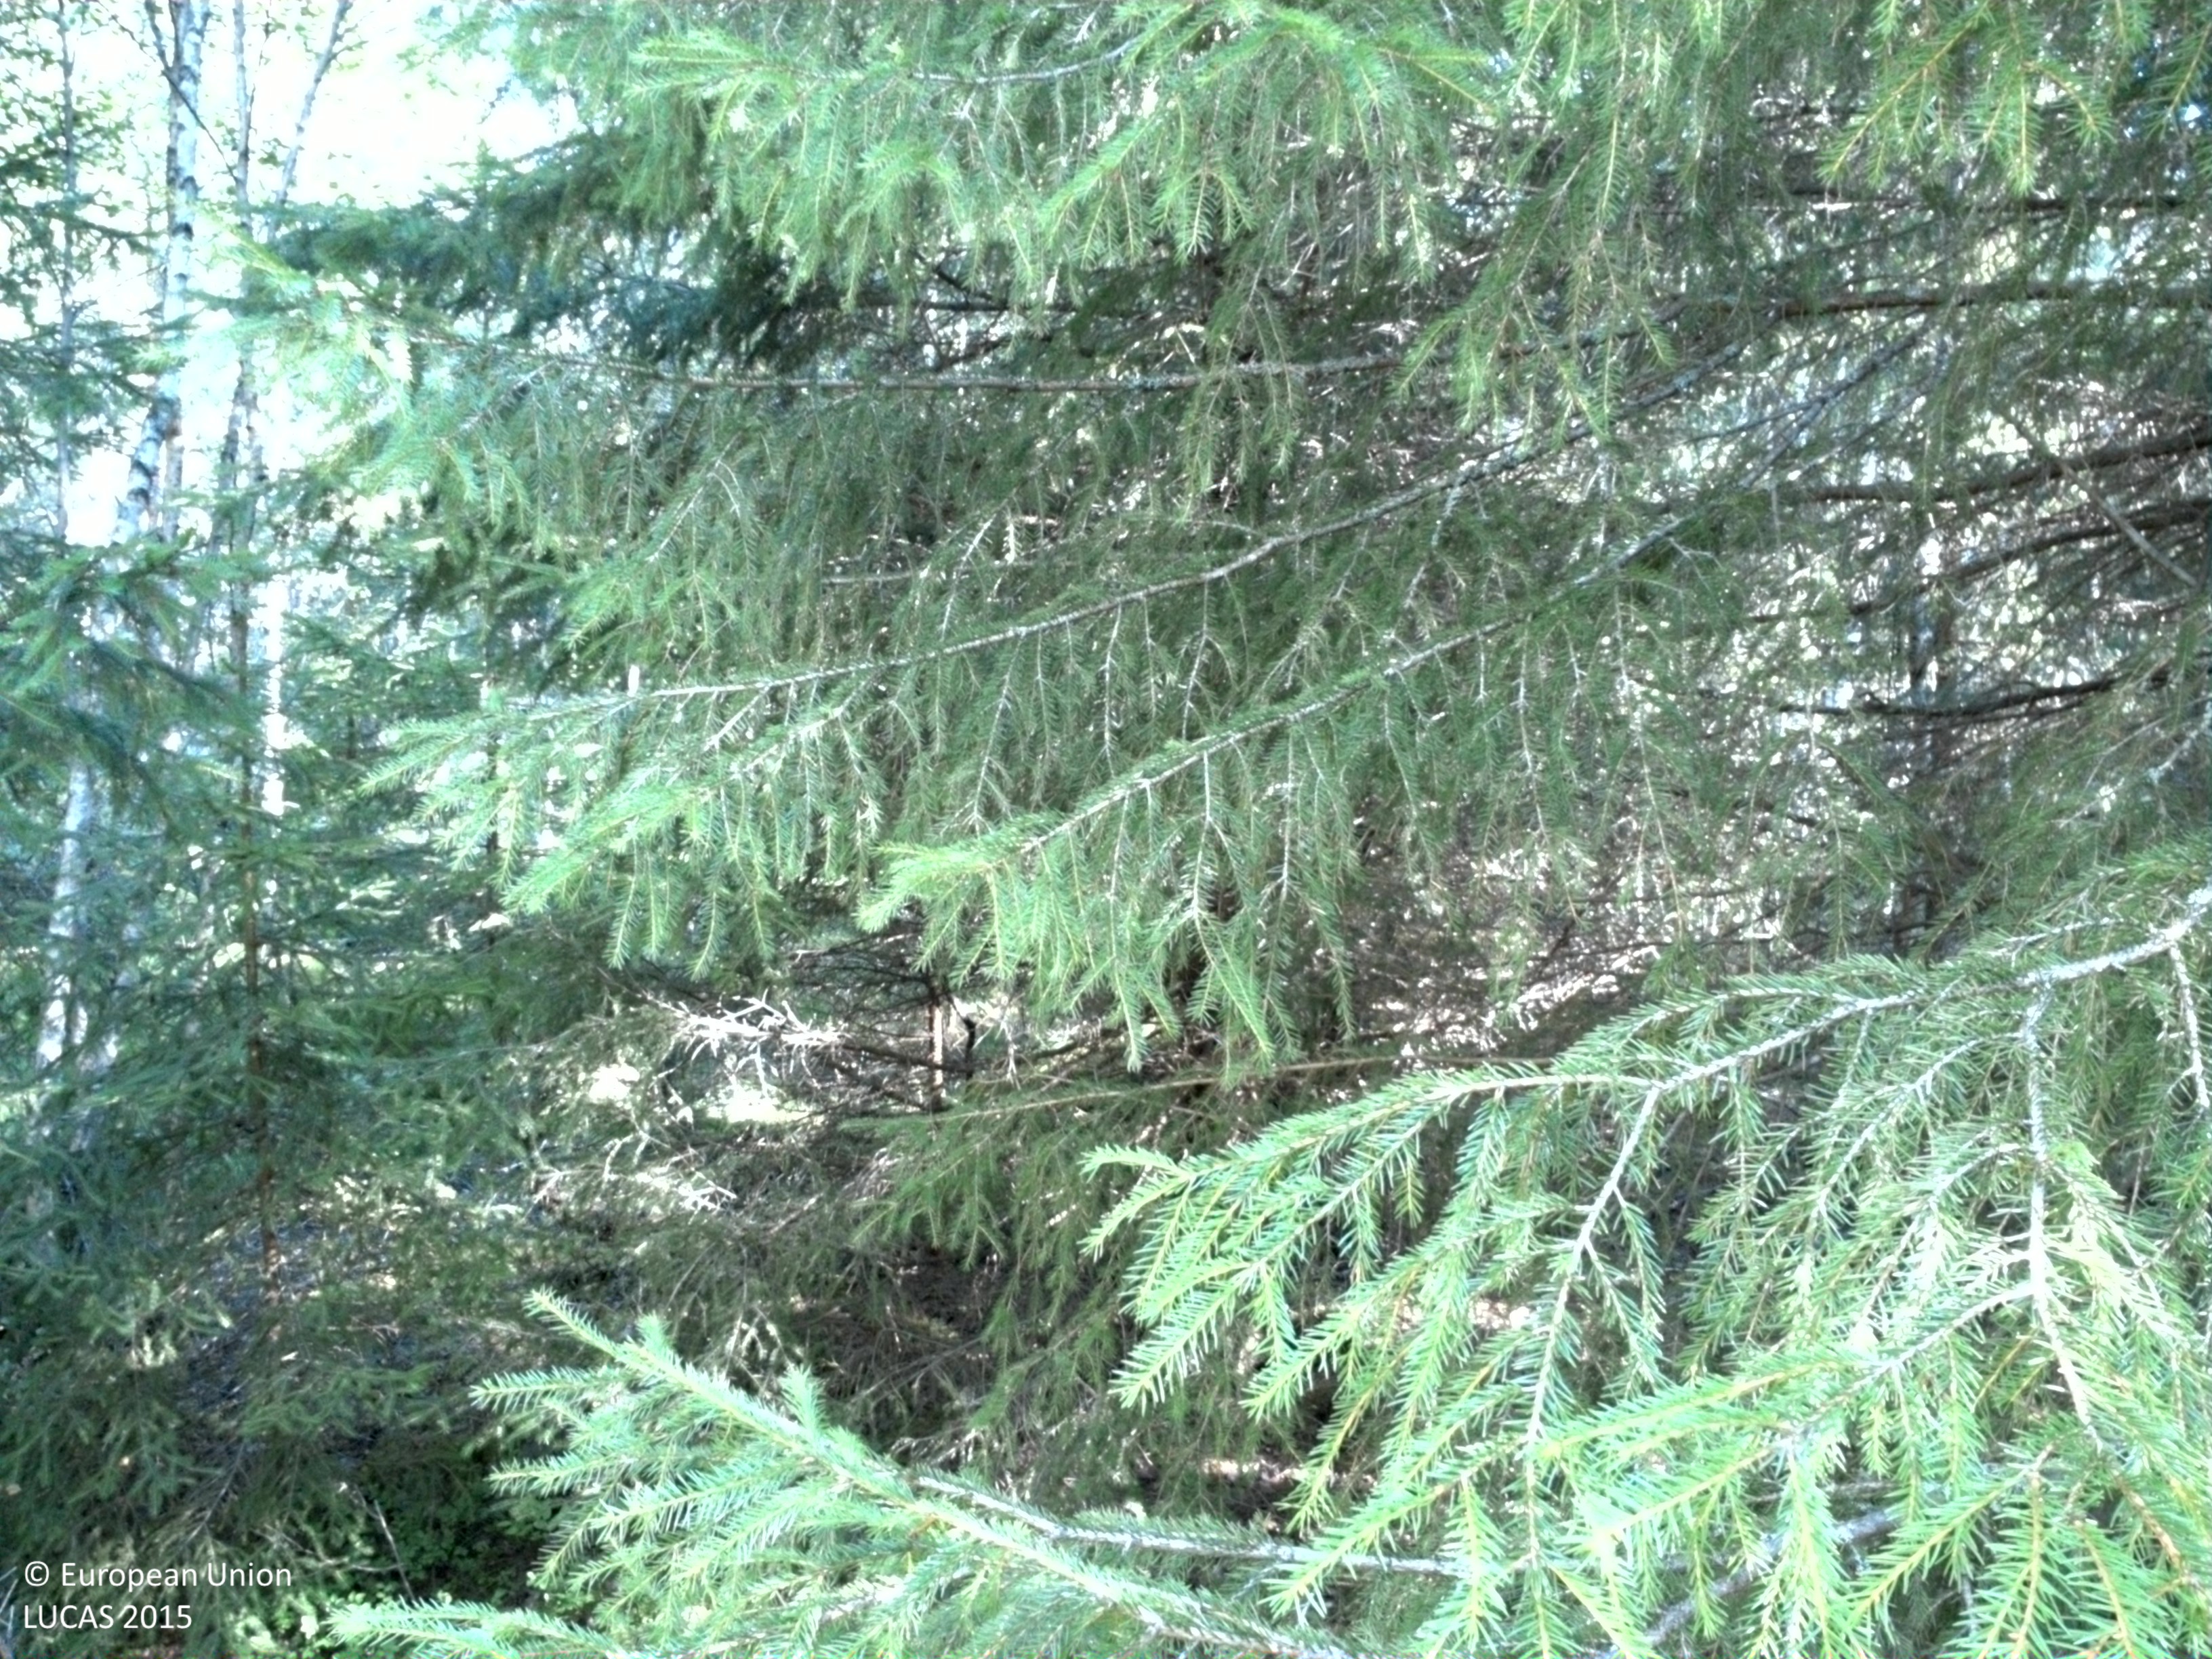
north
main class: Woodland
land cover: Spruce dominated mixed woodland
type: boreal forest
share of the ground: 50 - 75 %
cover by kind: coniferous forest trees 45 %, broadleaved forest trees 30 %, lichens and mosses 15 %, herbaceous plants 10 %
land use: Forestry
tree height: > 5 m
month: August
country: SE
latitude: 59.7669
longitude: 17.7762
